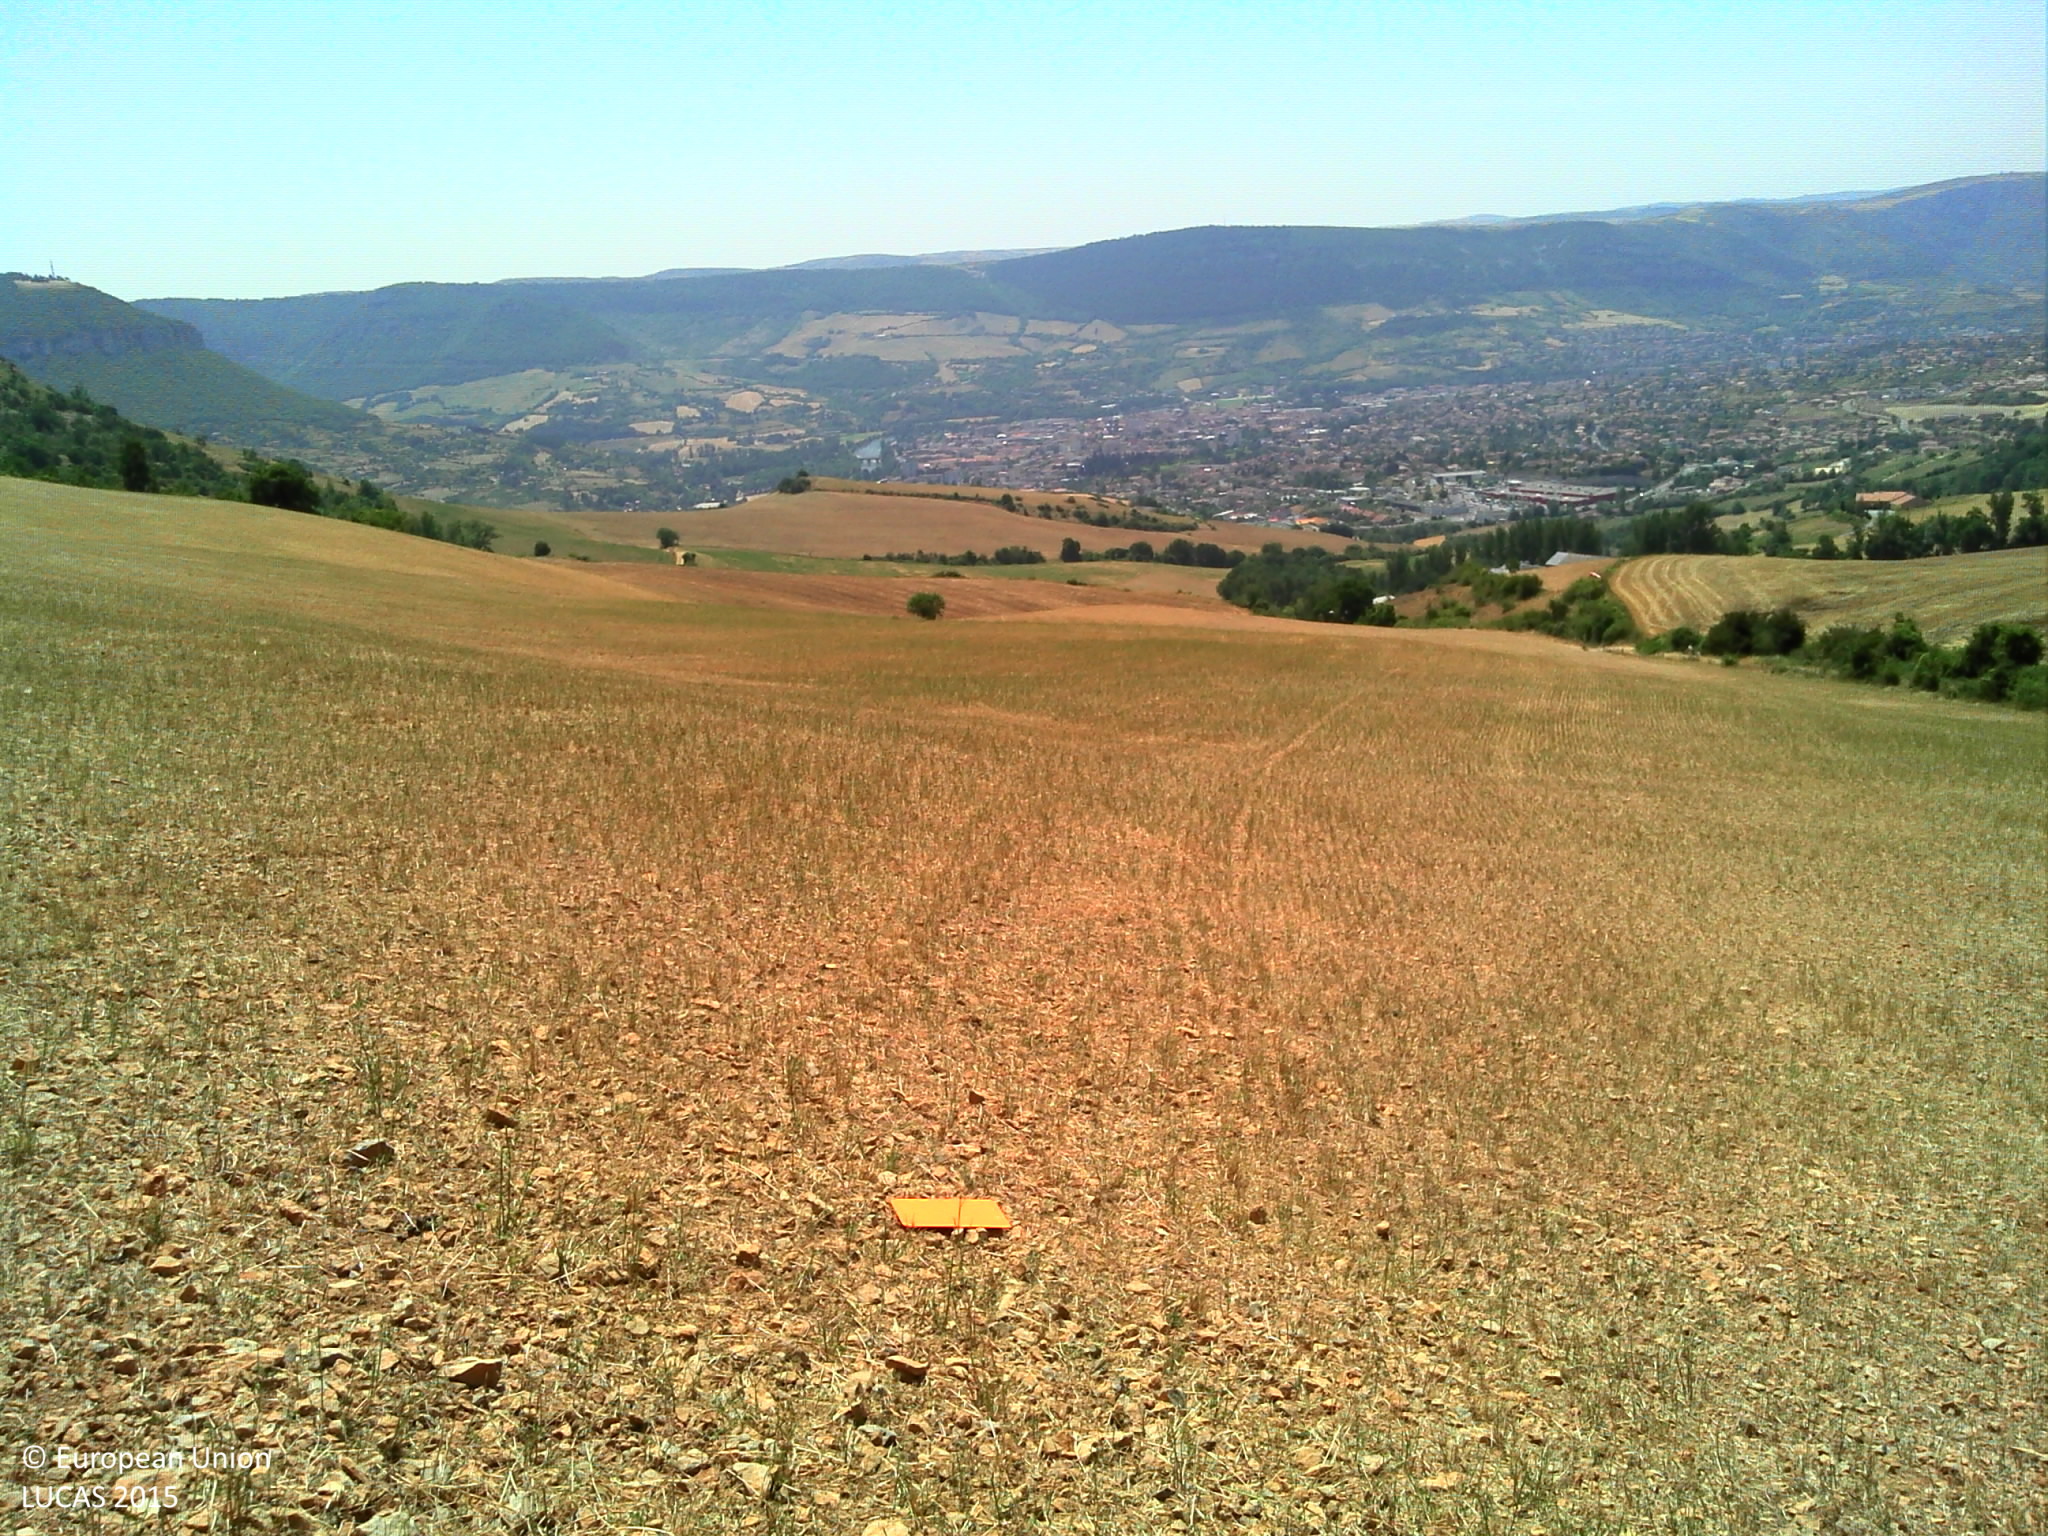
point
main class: Cropland
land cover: Temporary grasslands
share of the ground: 25 - 50 %
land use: Agriculture (excluding fallow land and kitchen gardens)
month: July
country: FR
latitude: 44.1367
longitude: 3.0684
